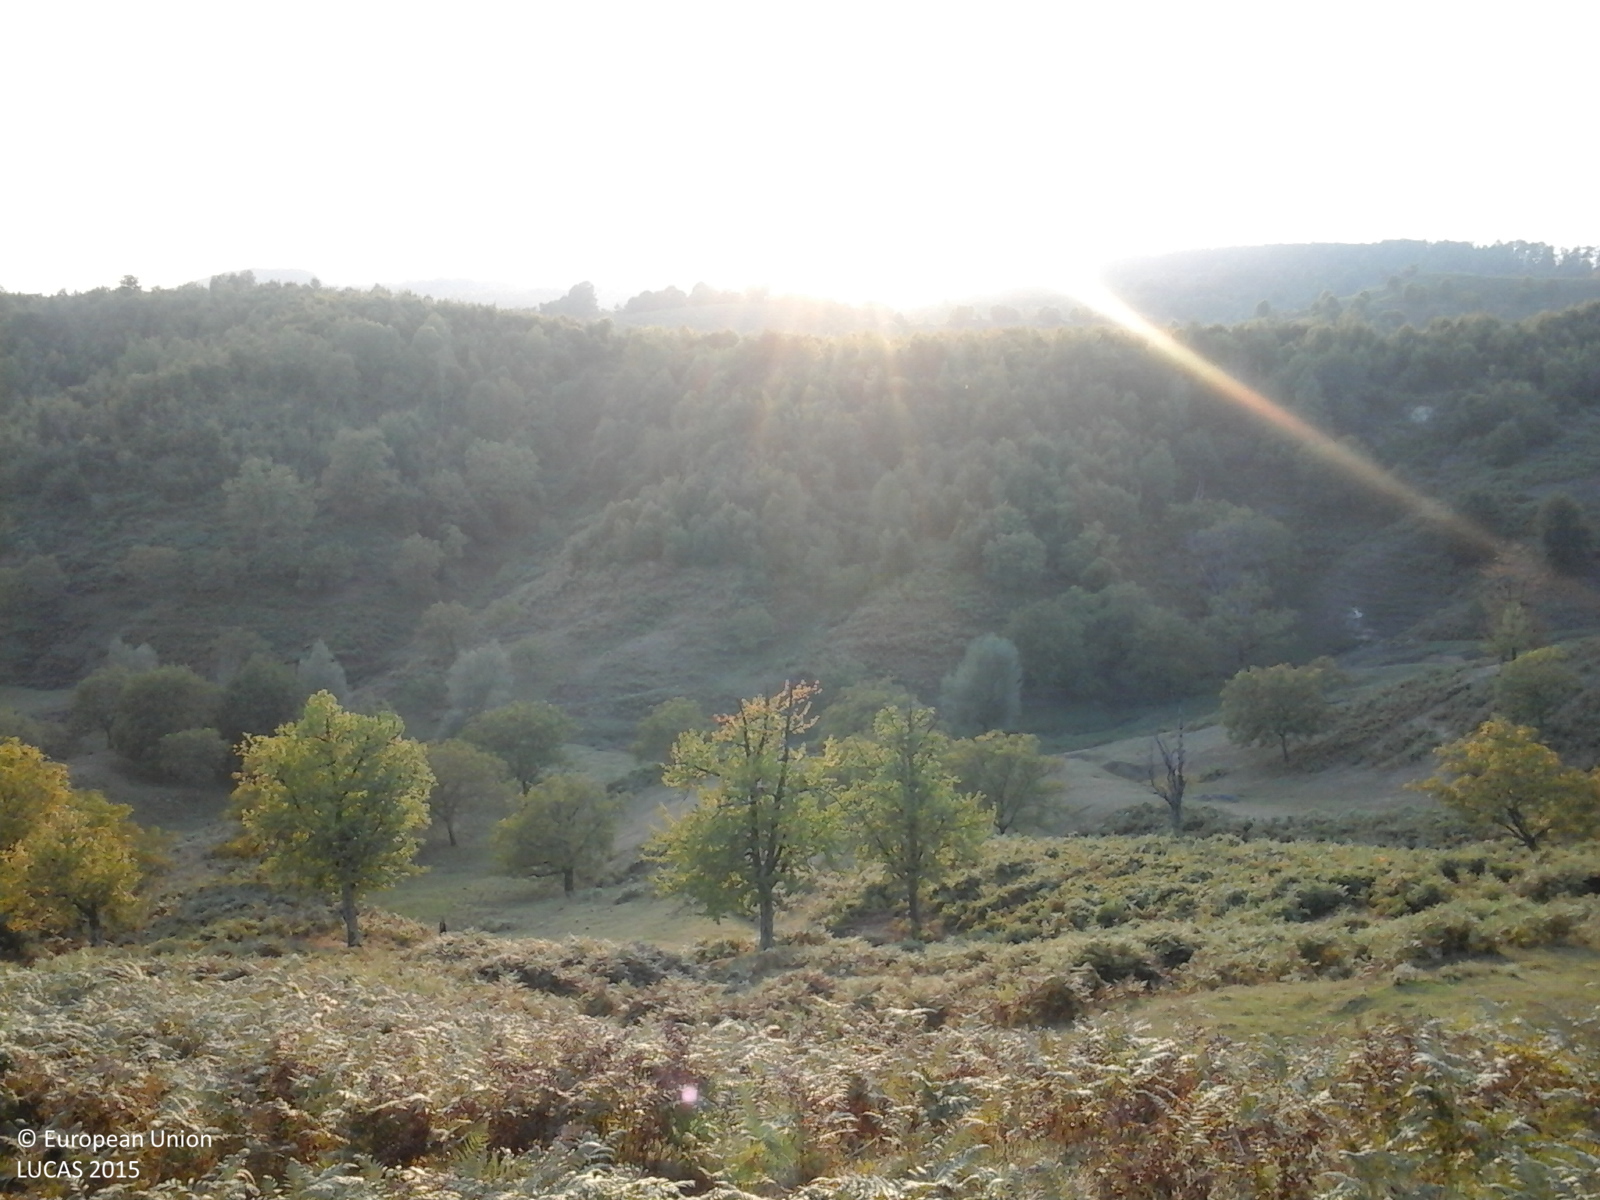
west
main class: Grassland
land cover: Grassland with sparse tree/shrub cover
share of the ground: > 75 %
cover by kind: herbaceous plants 85 %, shrubs 10 %, broadleaved forest trees 5 %
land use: Agriculture (excluding fallow land and kitchen gardens)
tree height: > 5 m
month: September
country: RO
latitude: 46.7530
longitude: 22.4228
